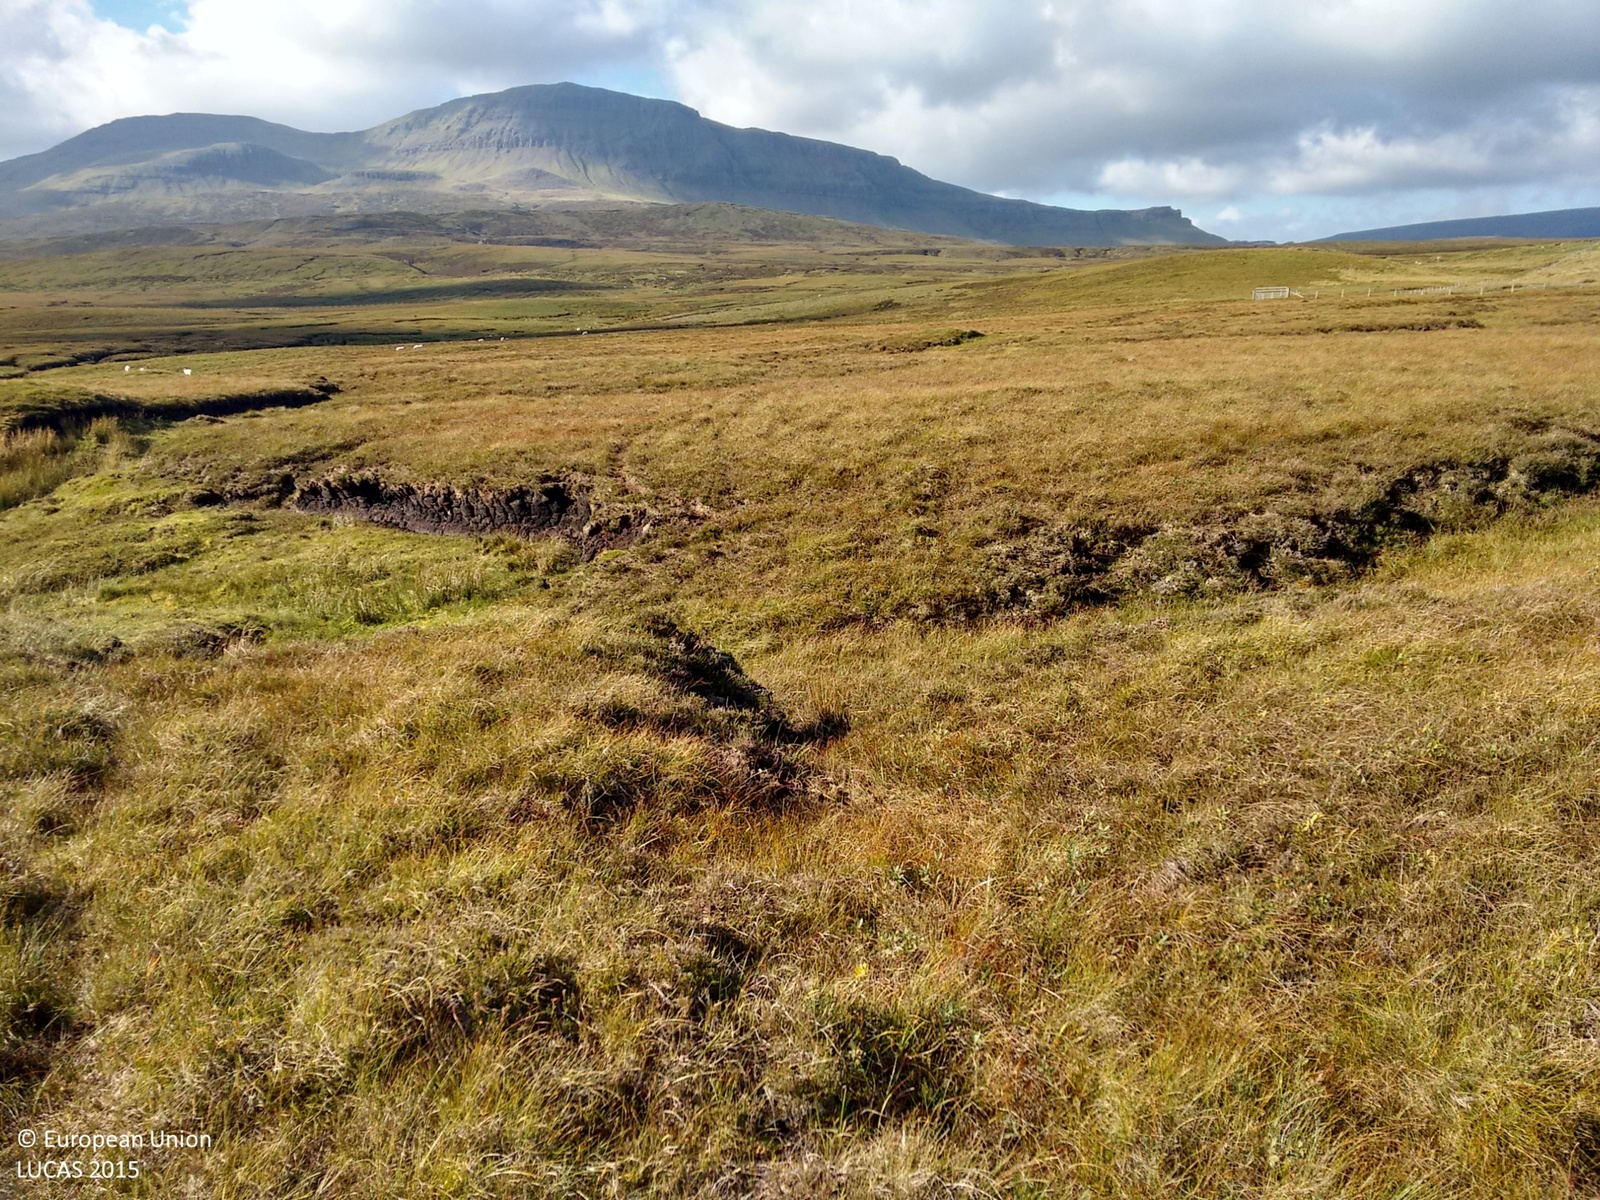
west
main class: Shrubland
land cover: Shrubland without tree cover
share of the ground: > 75 %
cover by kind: herbaceous plants 65 %, shrubs 30 %, lichens and mosses 5 %
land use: Agriculture (excluding fallow land and kitchen gardens)
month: September
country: GB
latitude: 57.5932
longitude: -6.2111
